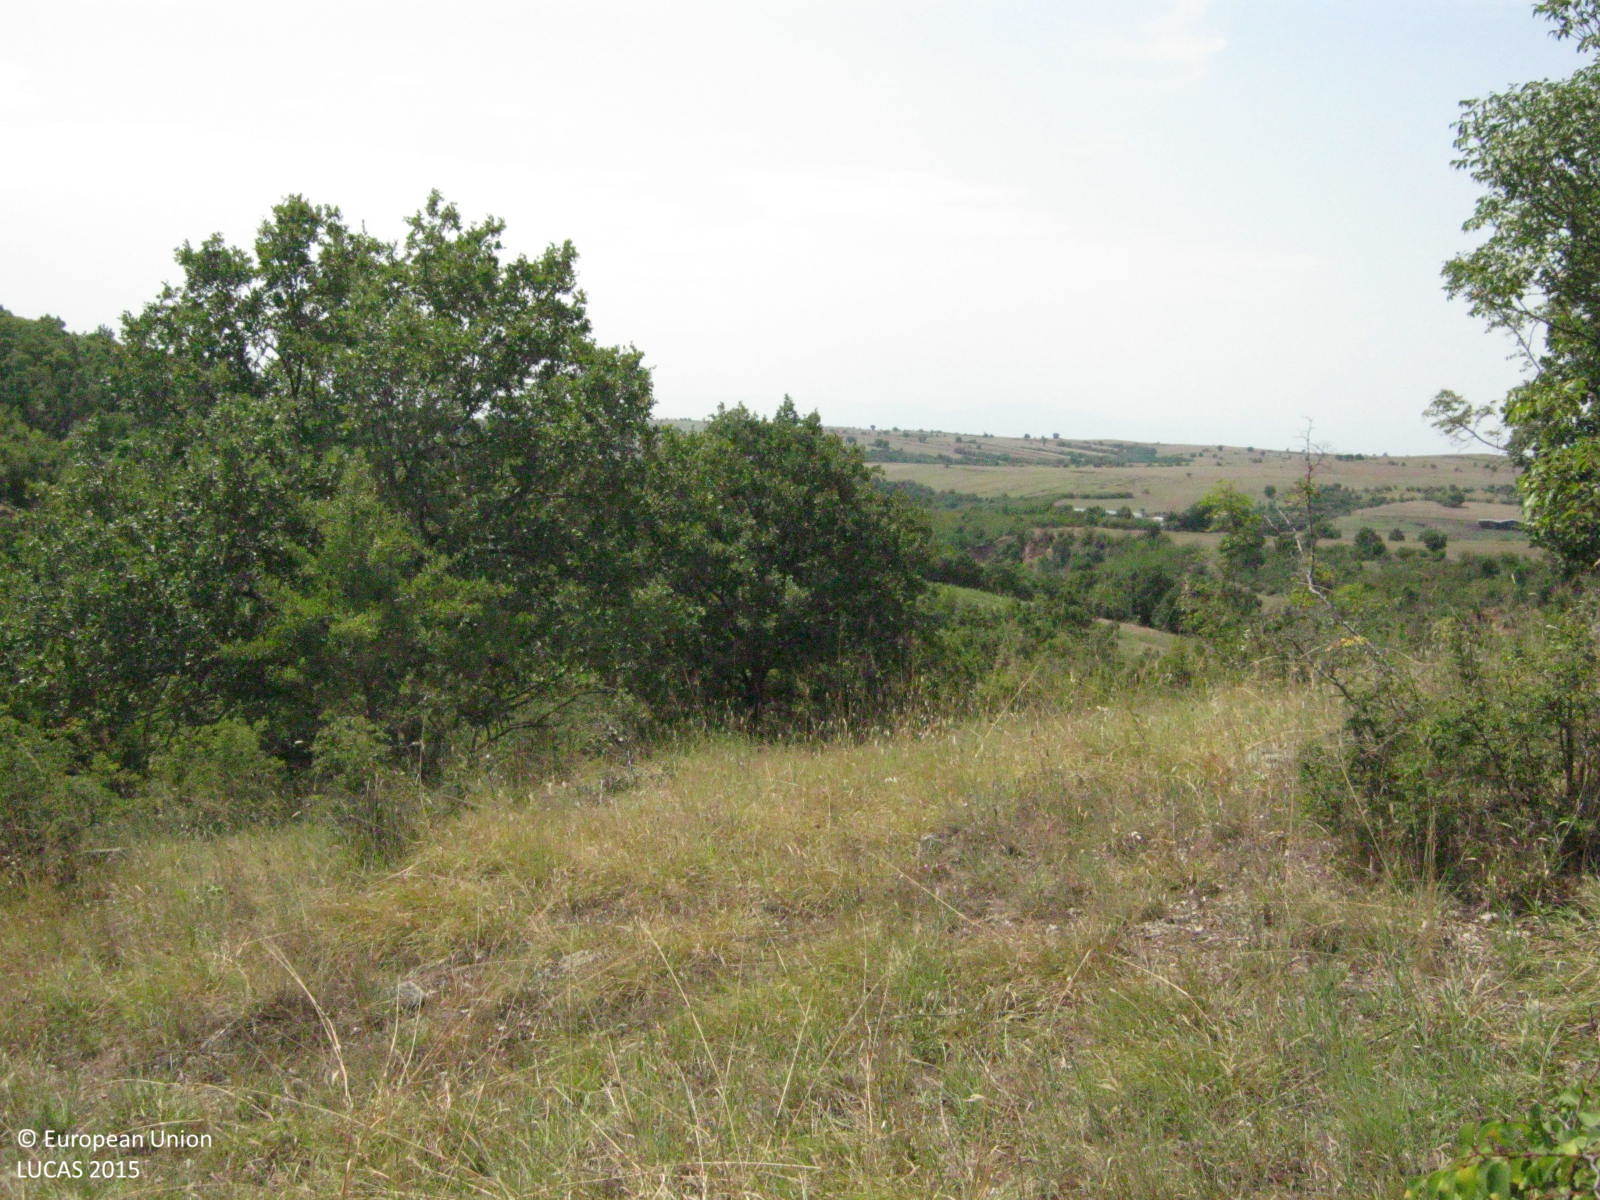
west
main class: Woodland
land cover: Broadleaved woodland
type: thermophilous deciduous forest
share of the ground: 10 - 25 %
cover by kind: herbaceous plants 70 %, broadleaved forest trees 20 %, shrubs 10 %
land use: Semi-natural and natural areas not in use
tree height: > 5 m
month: August
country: GR
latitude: 40.9360
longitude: 22.9927
